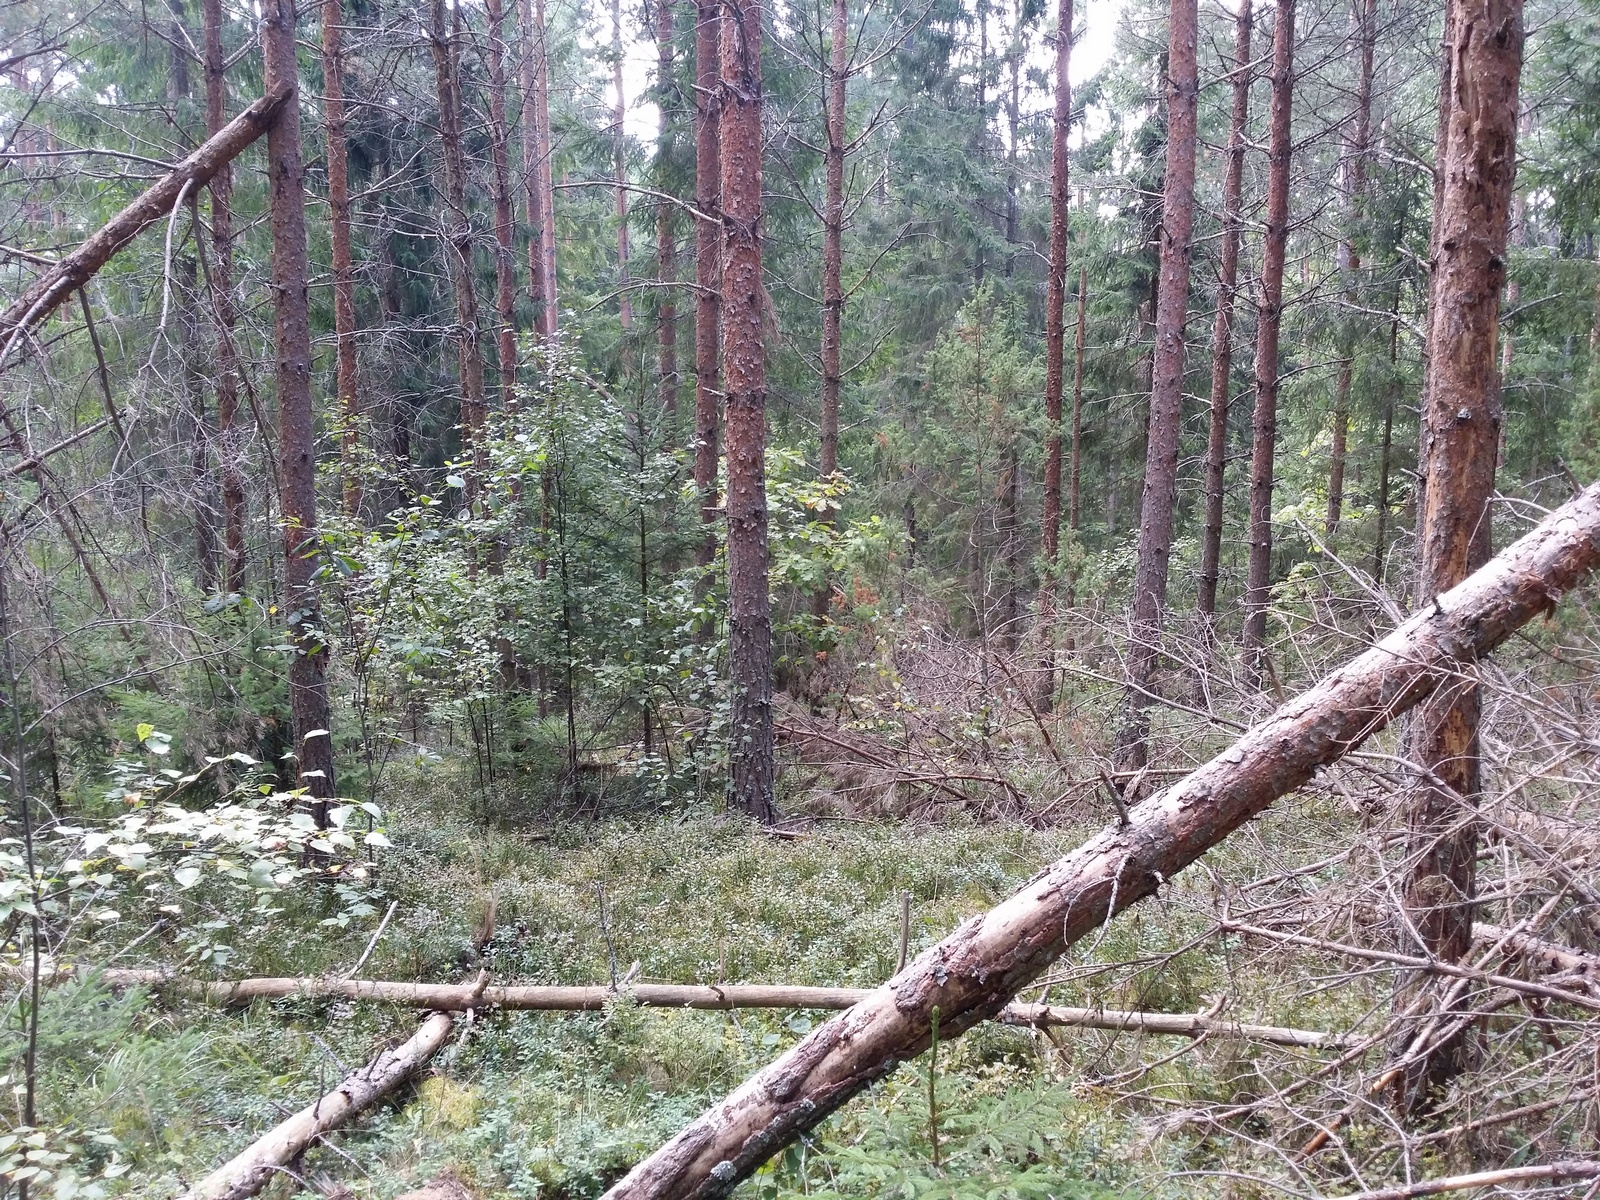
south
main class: Woodland
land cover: Other coniferous woodland
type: hemiboreal forest and nemoral coniferous forest and mixed broadleaved-coniferous forest
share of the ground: > 75 %
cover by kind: coniferous forest trees 80 %, shrubs 10 %, lichens and mosses 10 %
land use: Forestry
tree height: > 5 m
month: August
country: LV
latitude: 56.8737
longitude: 27.6223
